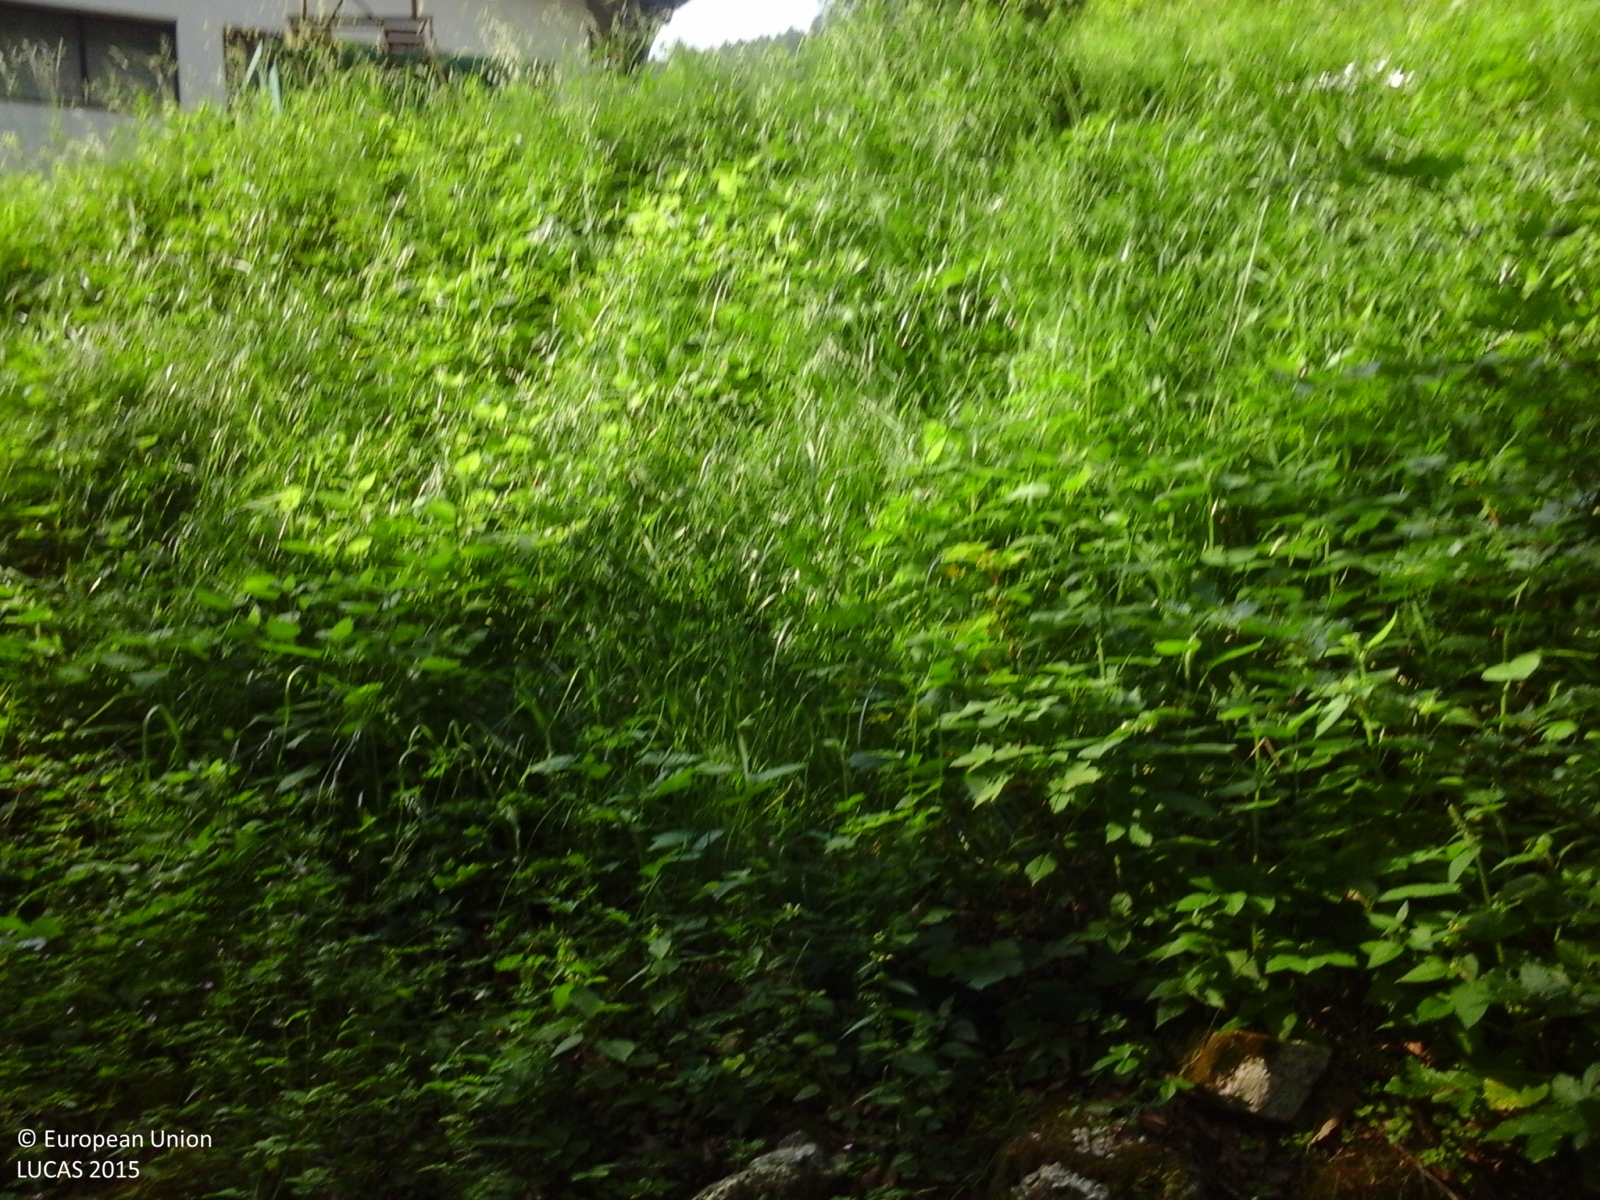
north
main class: Grassland
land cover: Grassland without tree/shrub cover
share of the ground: > 75 %
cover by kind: herbaceous plants 100 %
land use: Agriculture (excluding fallow land and kitchen gardens)
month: June
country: IT
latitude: 46.3468
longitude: 12.1934
